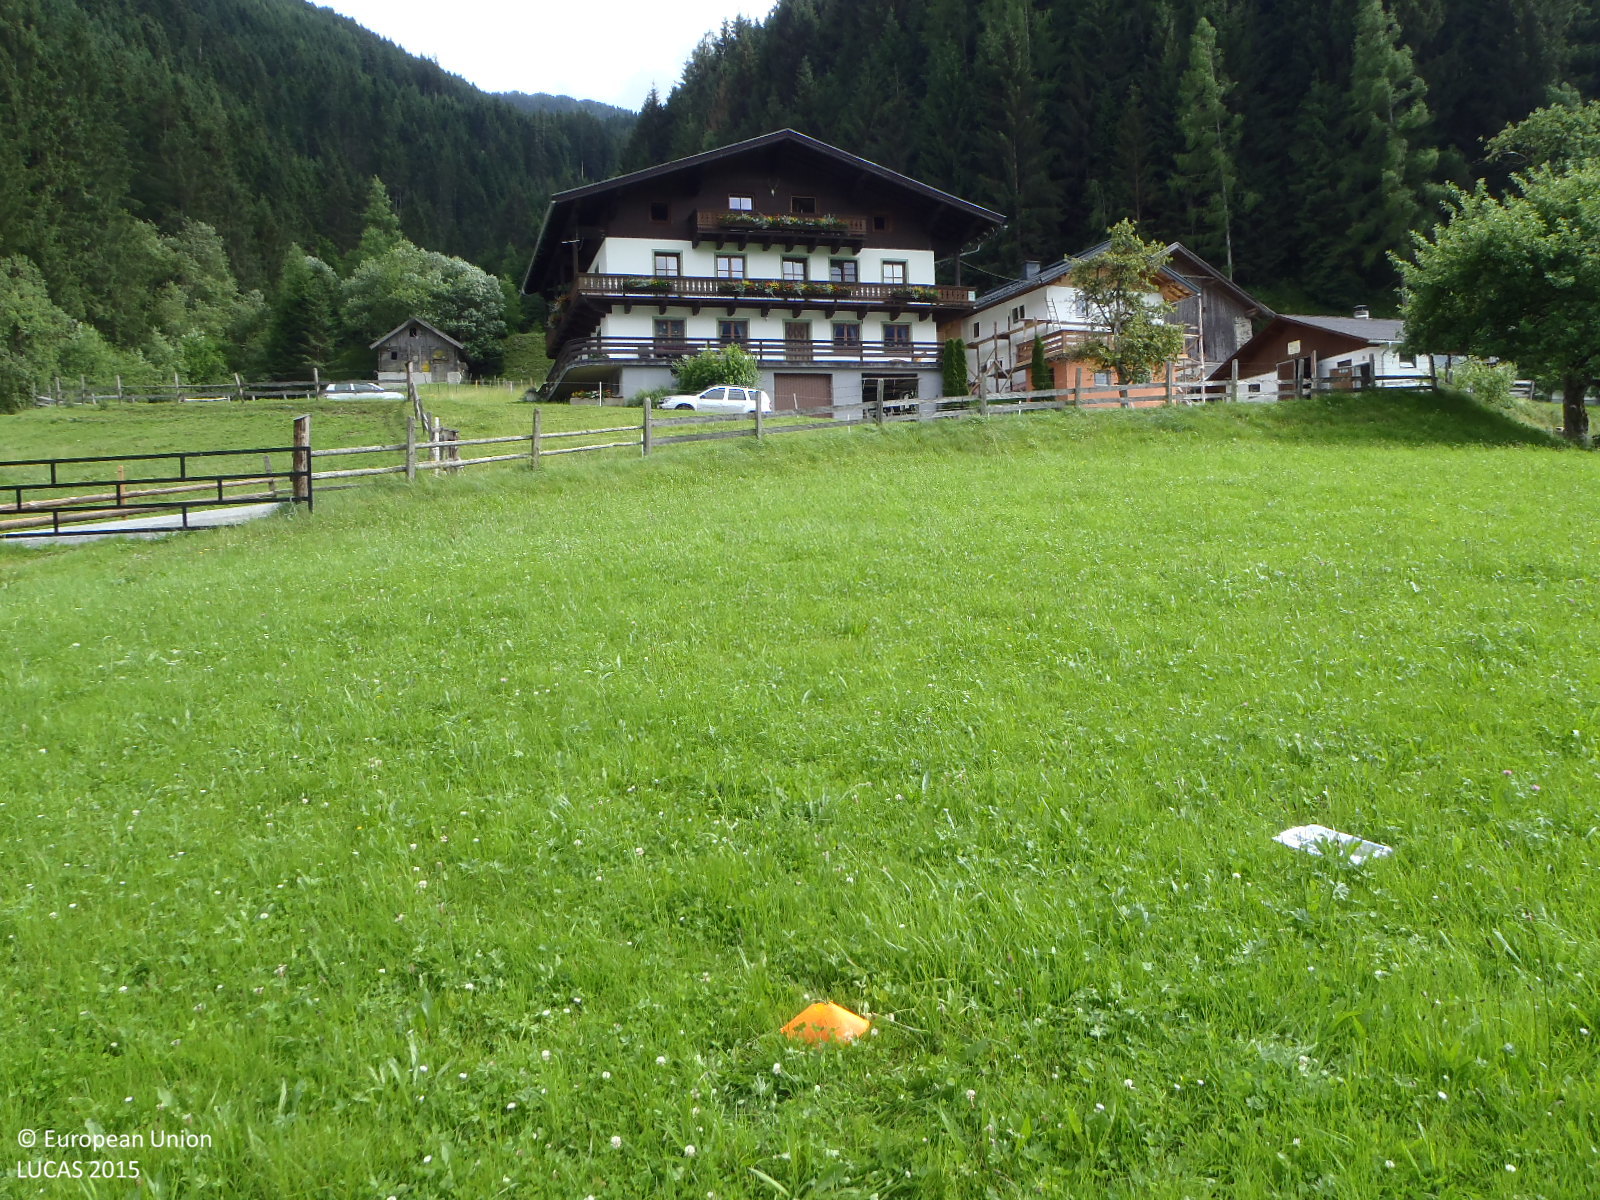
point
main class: Grassland
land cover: Grassland without tree/shrub cover
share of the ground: > 75 %
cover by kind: herbaceous plants 100 %
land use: Agriculture (excluding fallow land and kitchen gardens)
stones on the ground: < 10 %
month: June
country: AT
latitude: 47.2763
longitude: 12.5230
